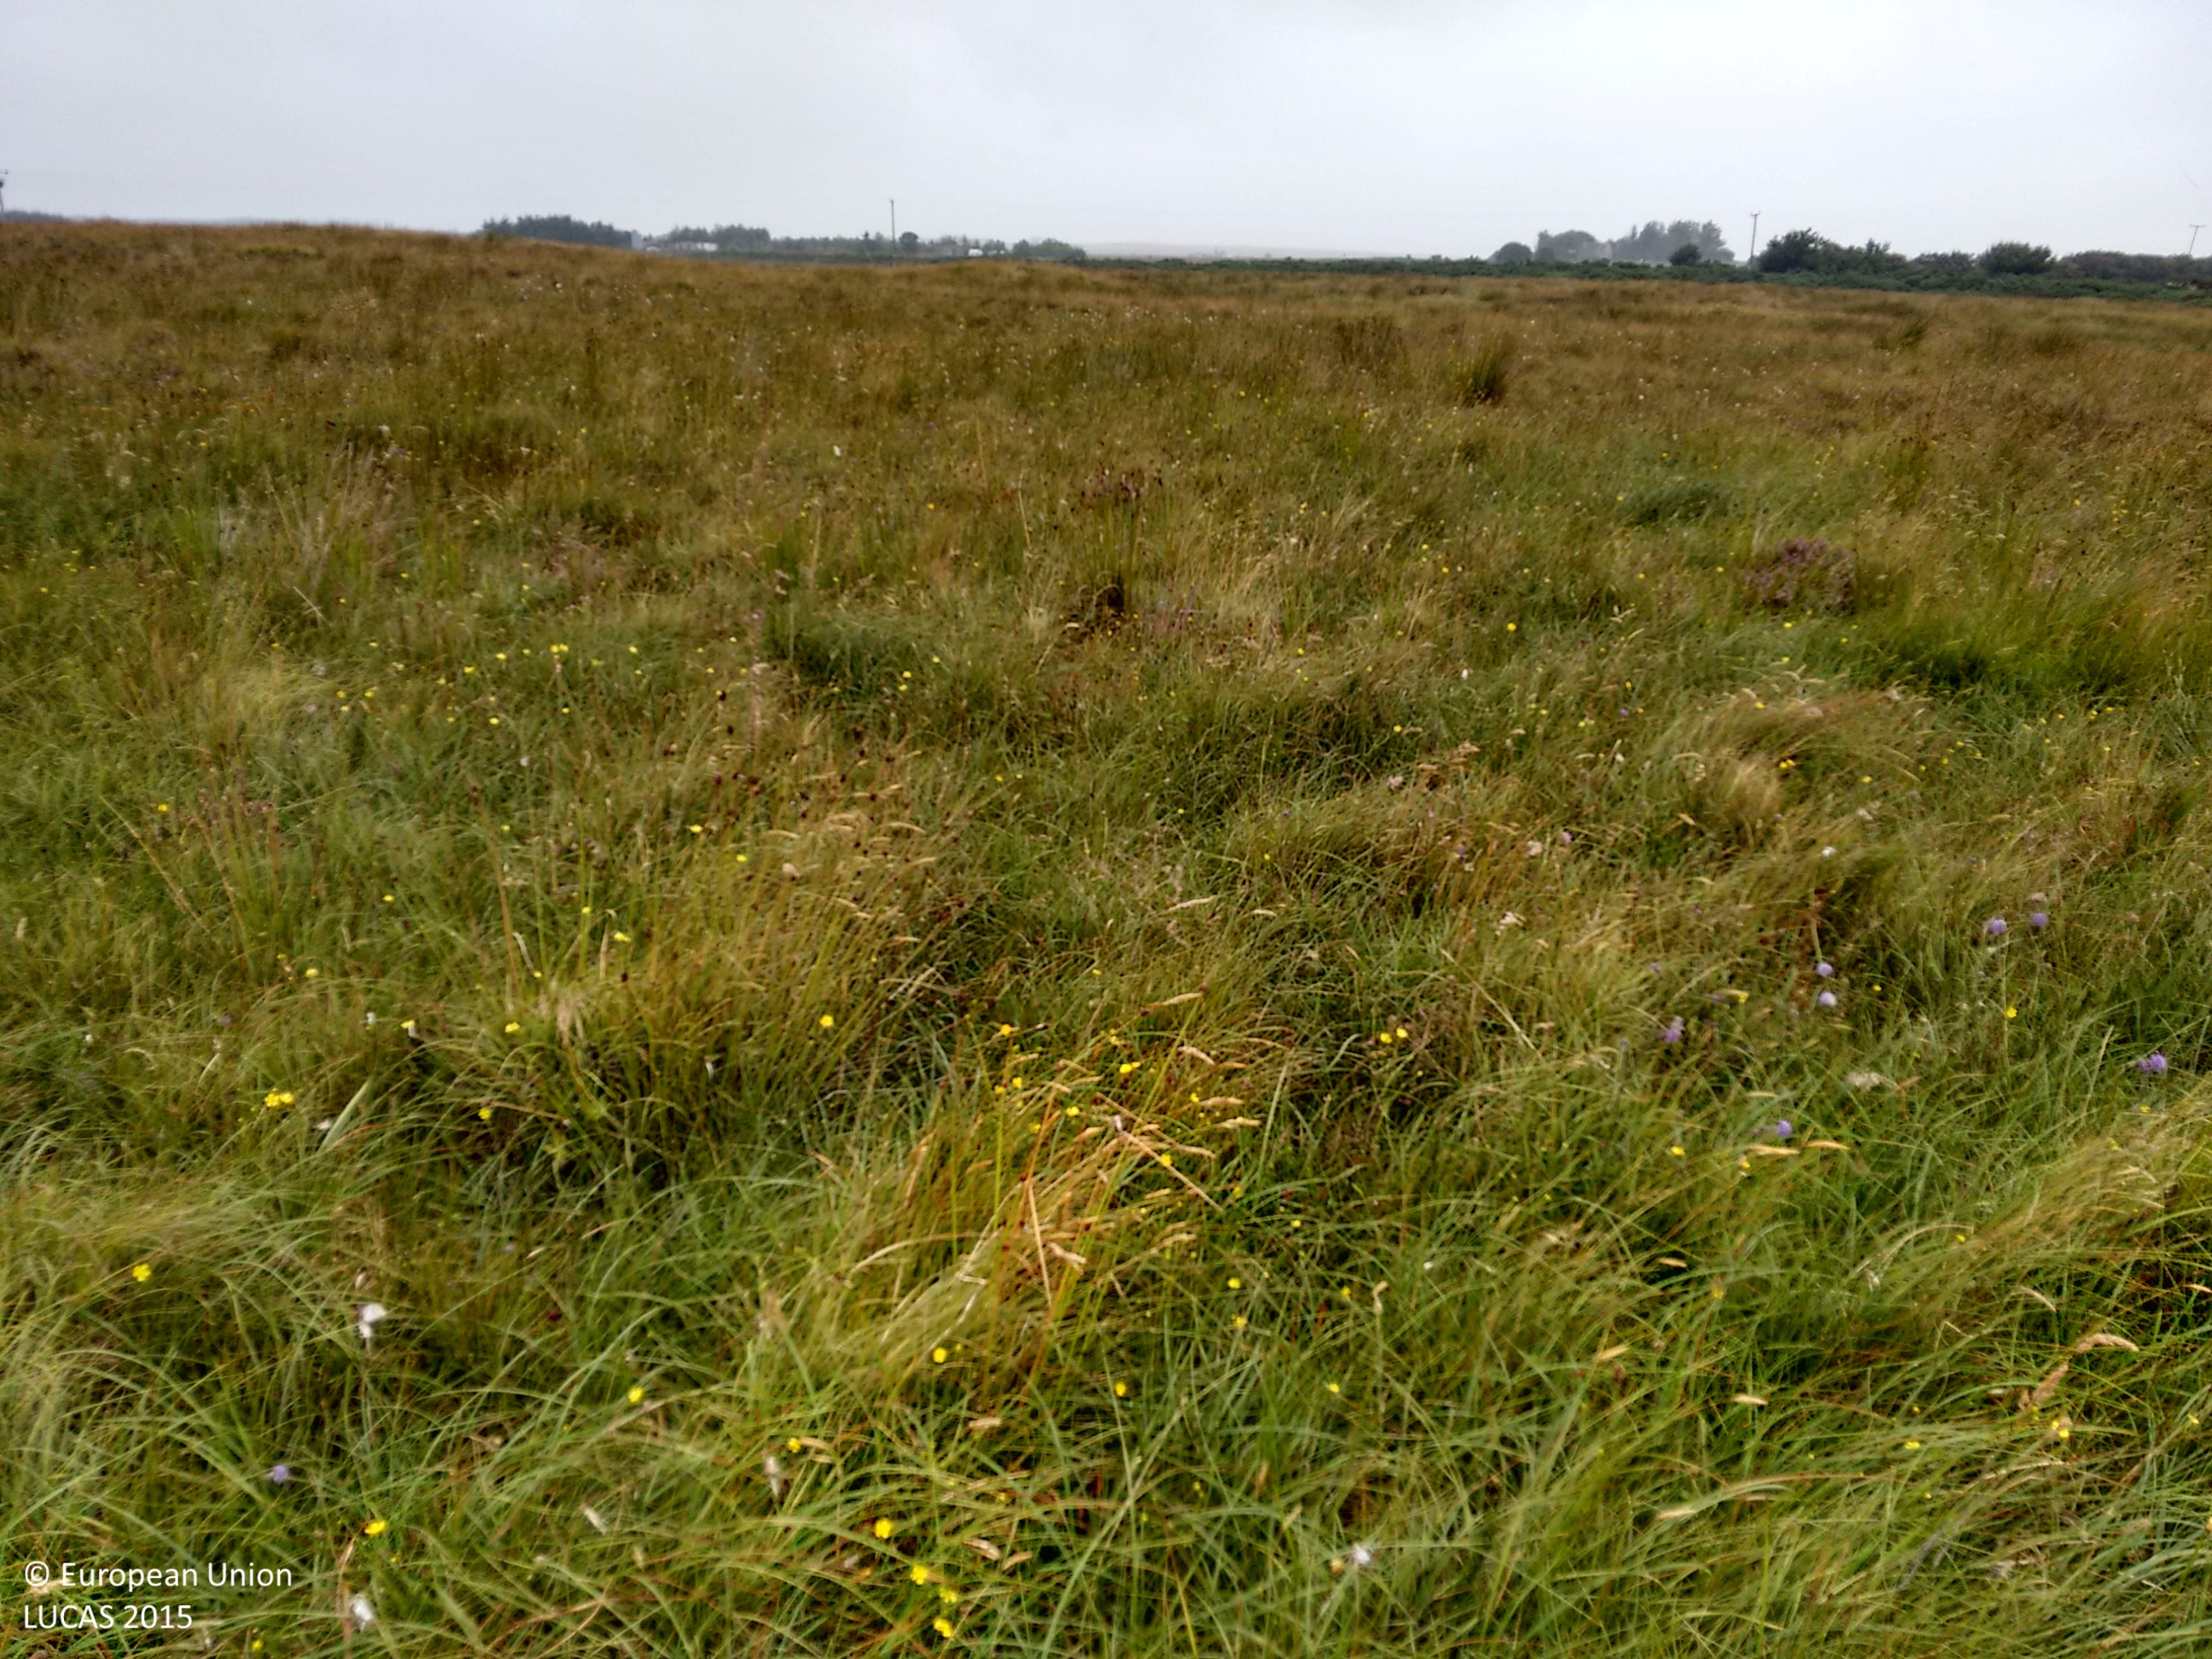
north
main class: Grassland
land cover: Grassland without tree/shrub cover
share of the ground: > 75 %
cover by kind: herbaceous plants 95 %, shrubs 5 %
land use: Agriculture (excluding fallow land and kitchen gardens)
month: August
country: GB
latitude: 58.5617
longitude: -3.2788
